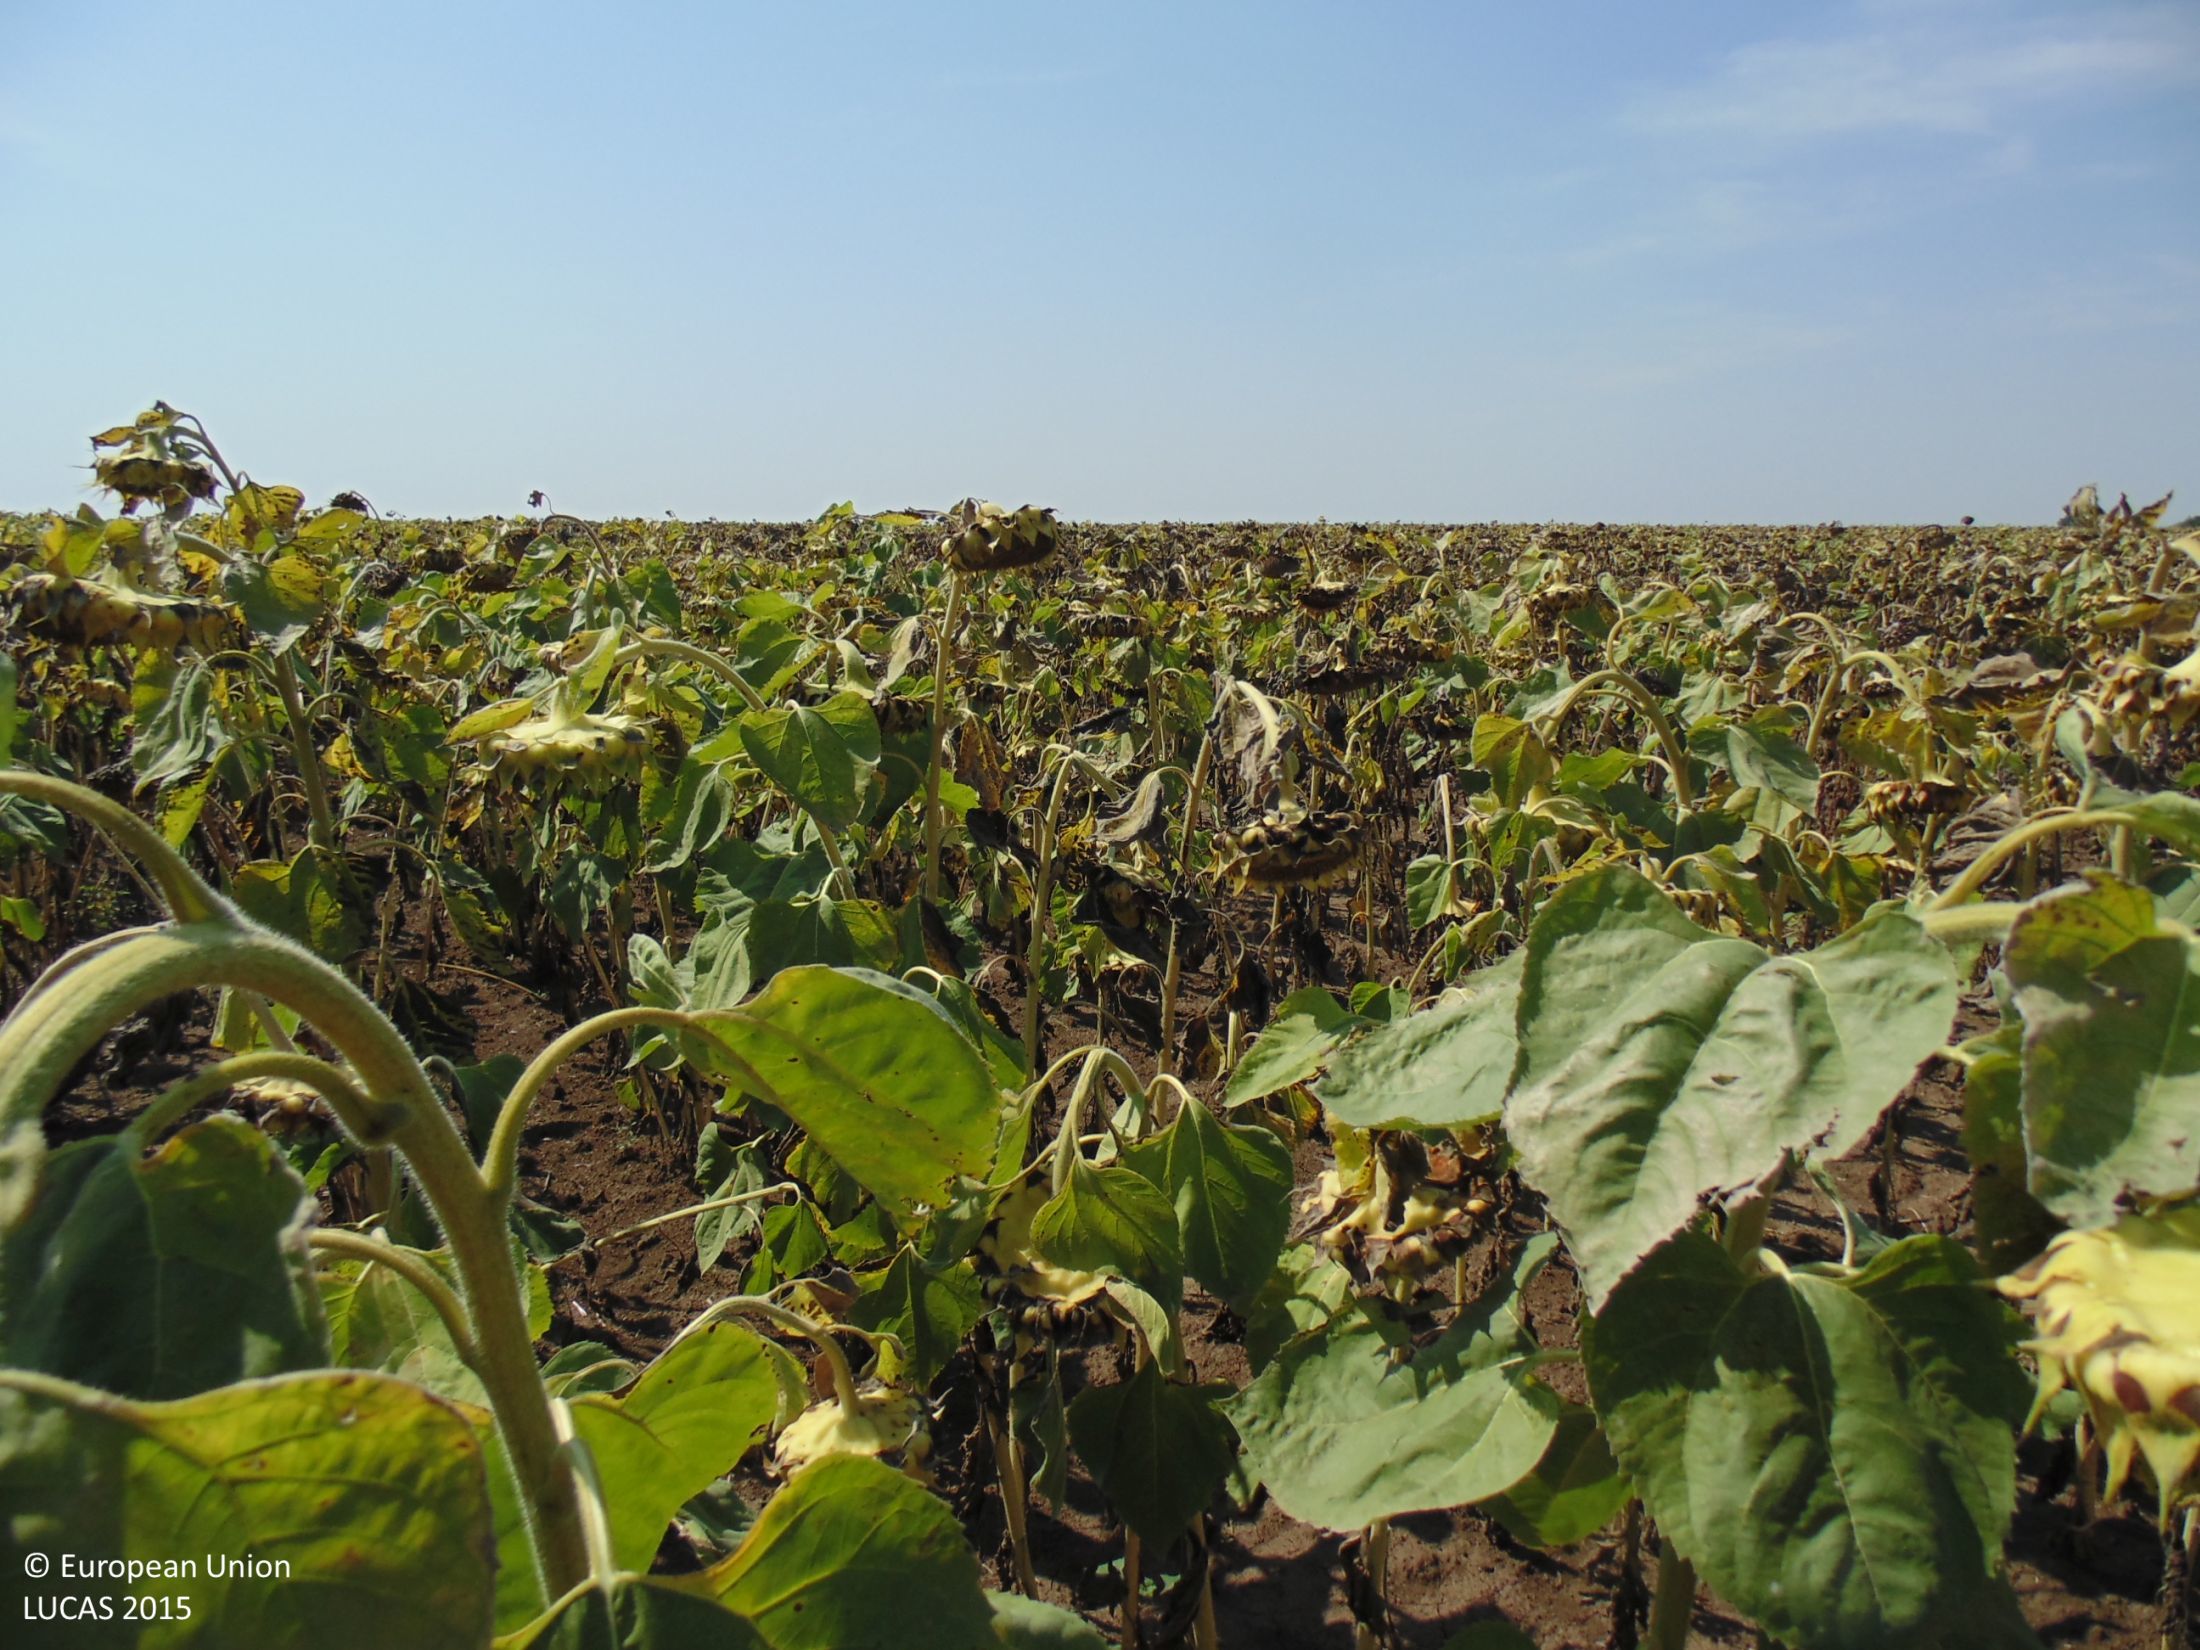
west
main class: Cropland
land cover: Sunflower
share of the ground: > 75 %
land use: Agriculture (excluding fallow land and kitchen gardens)
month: August
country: BG
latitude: 43.7547
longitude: 27.4842
